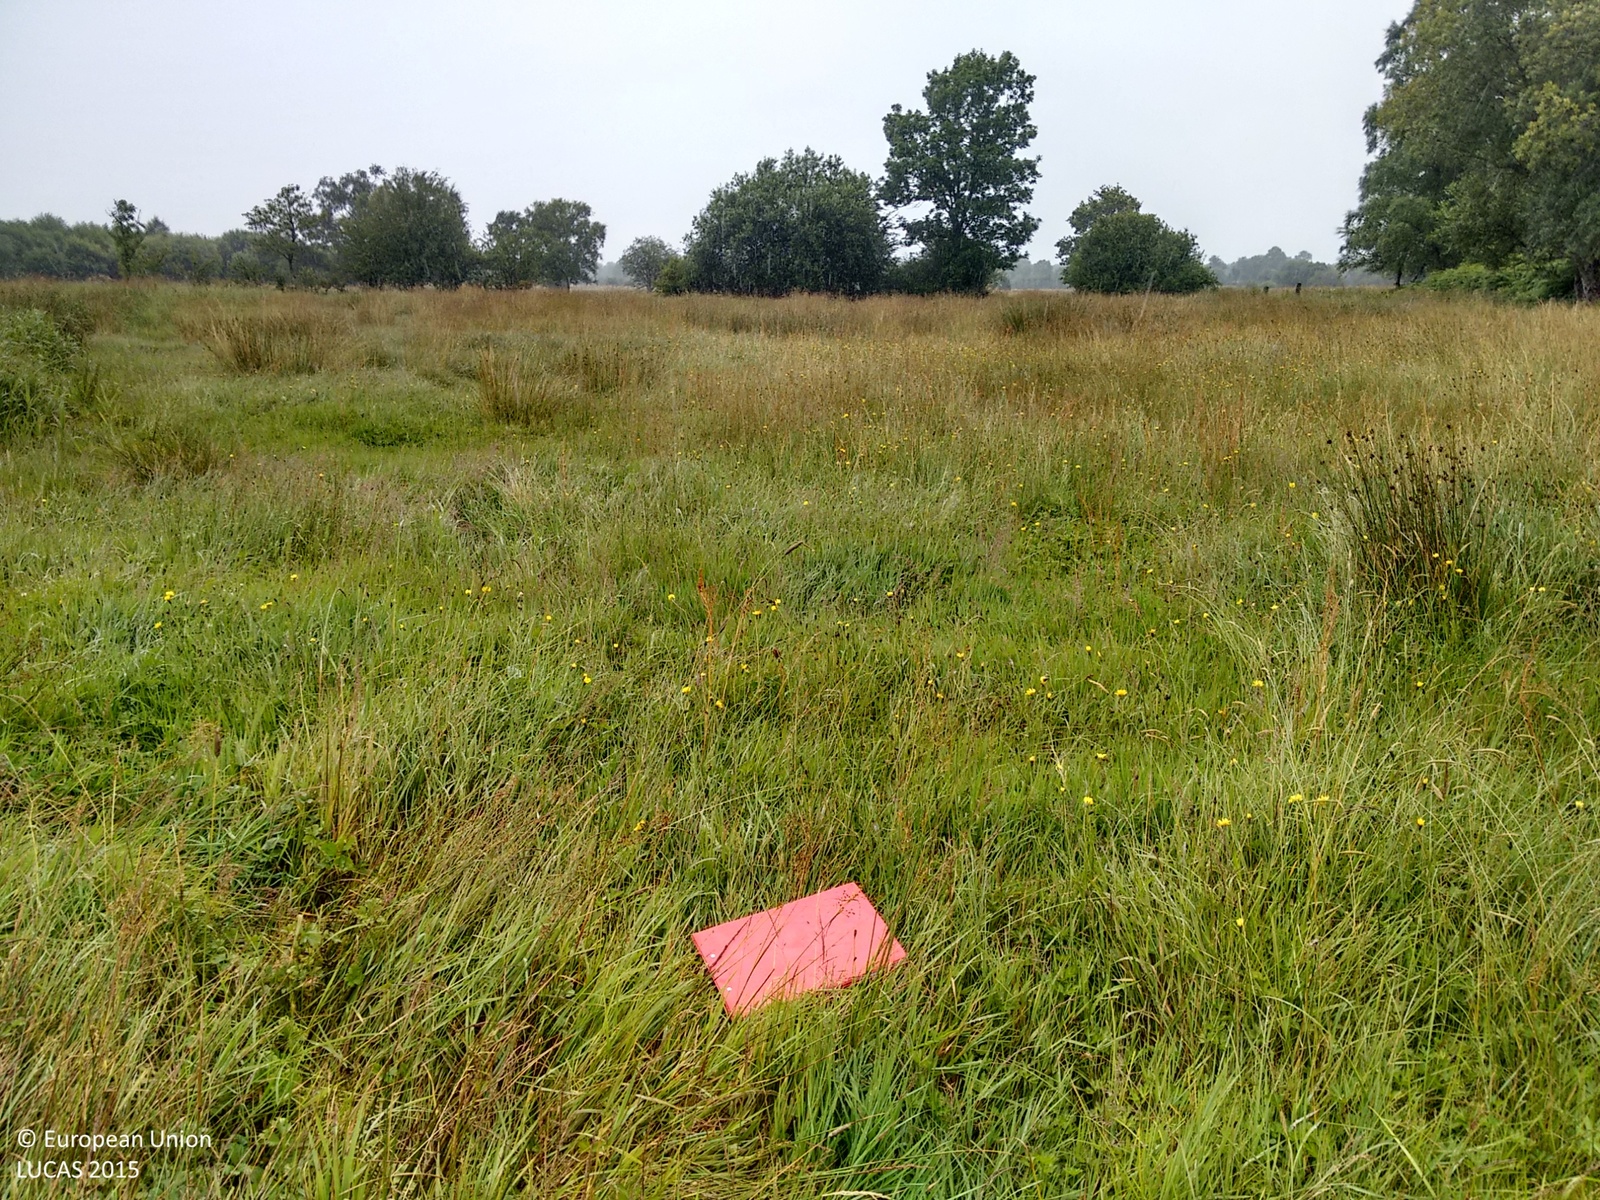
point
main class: Grassland
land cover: Grassland without tree/shrub cover
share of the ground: > 75 %
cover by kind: herbaceous plants 100 %
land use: Agriculture (excluding fallow land and kitchen gardens)
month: July
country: IE
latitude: 53.8103
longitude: -7.8622
